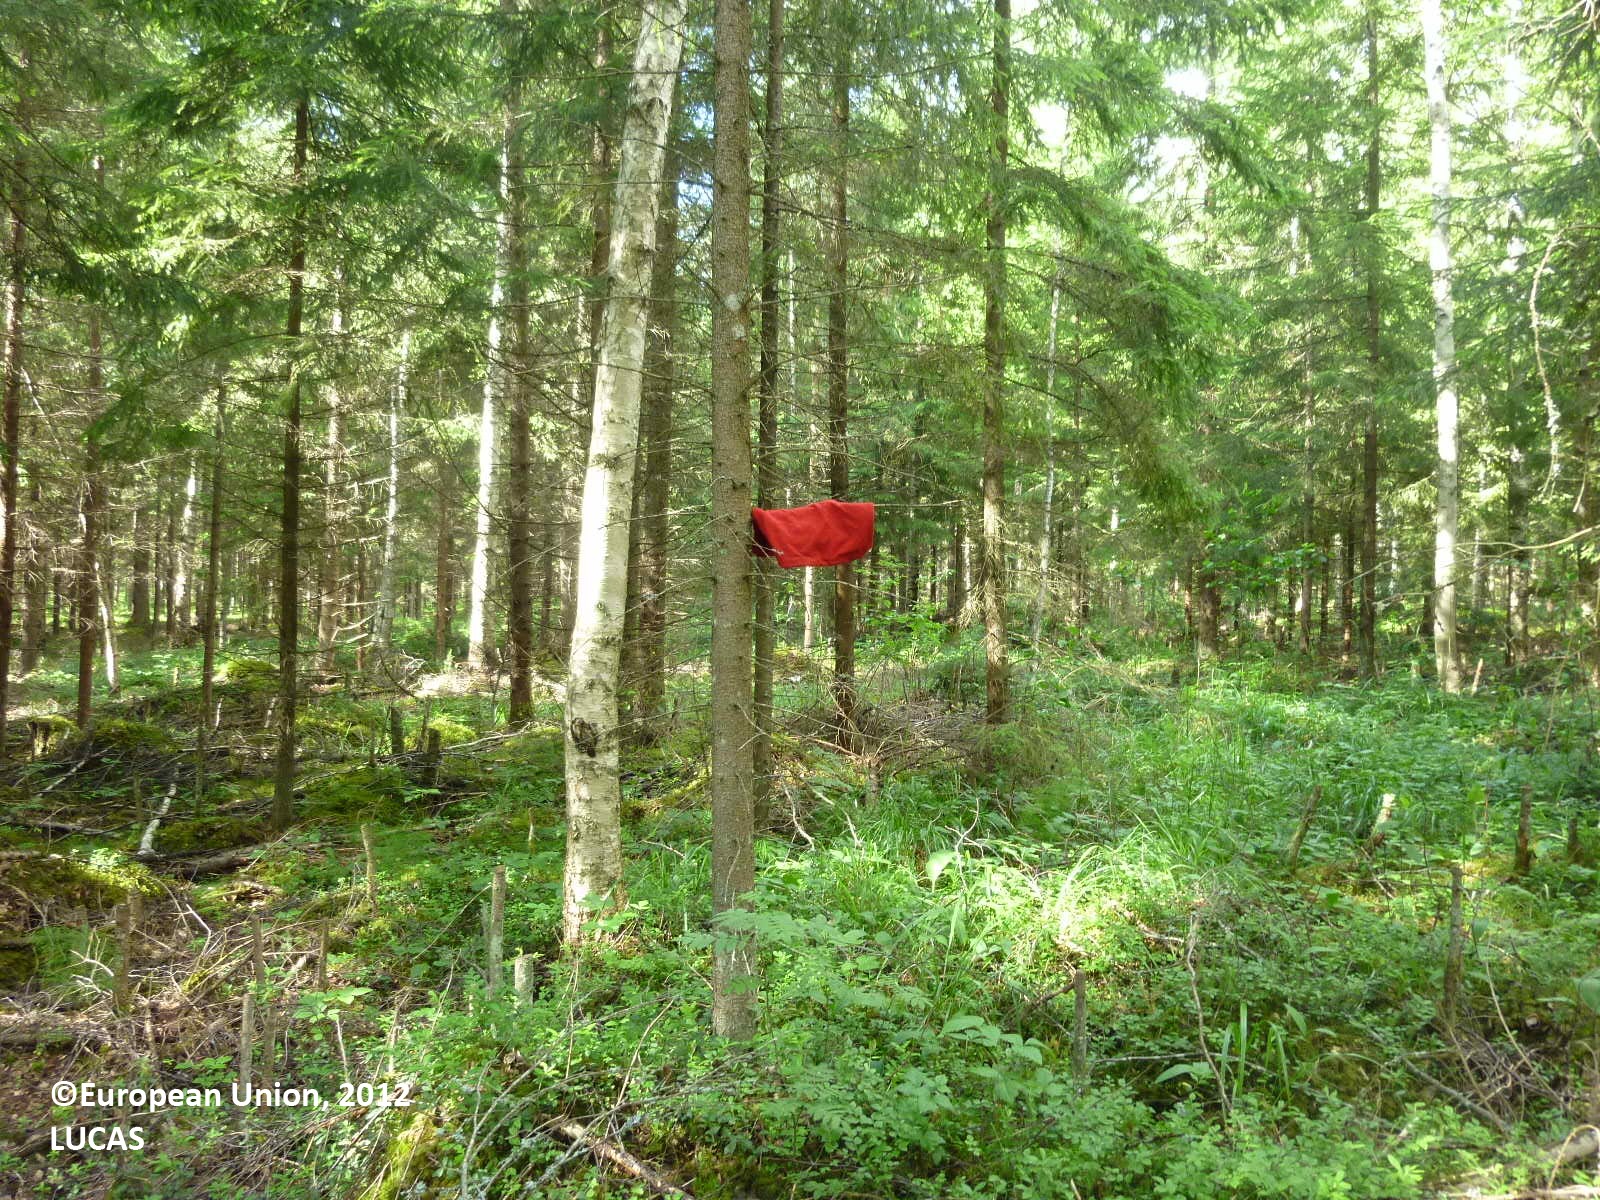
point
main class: Woodland
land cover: Spruce dominated mixed woodland
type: boreal forest
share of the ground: > 75 %
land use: Forestry
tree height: > 5 m
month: July
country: FI
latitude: 61.2563
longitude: 21.9696
